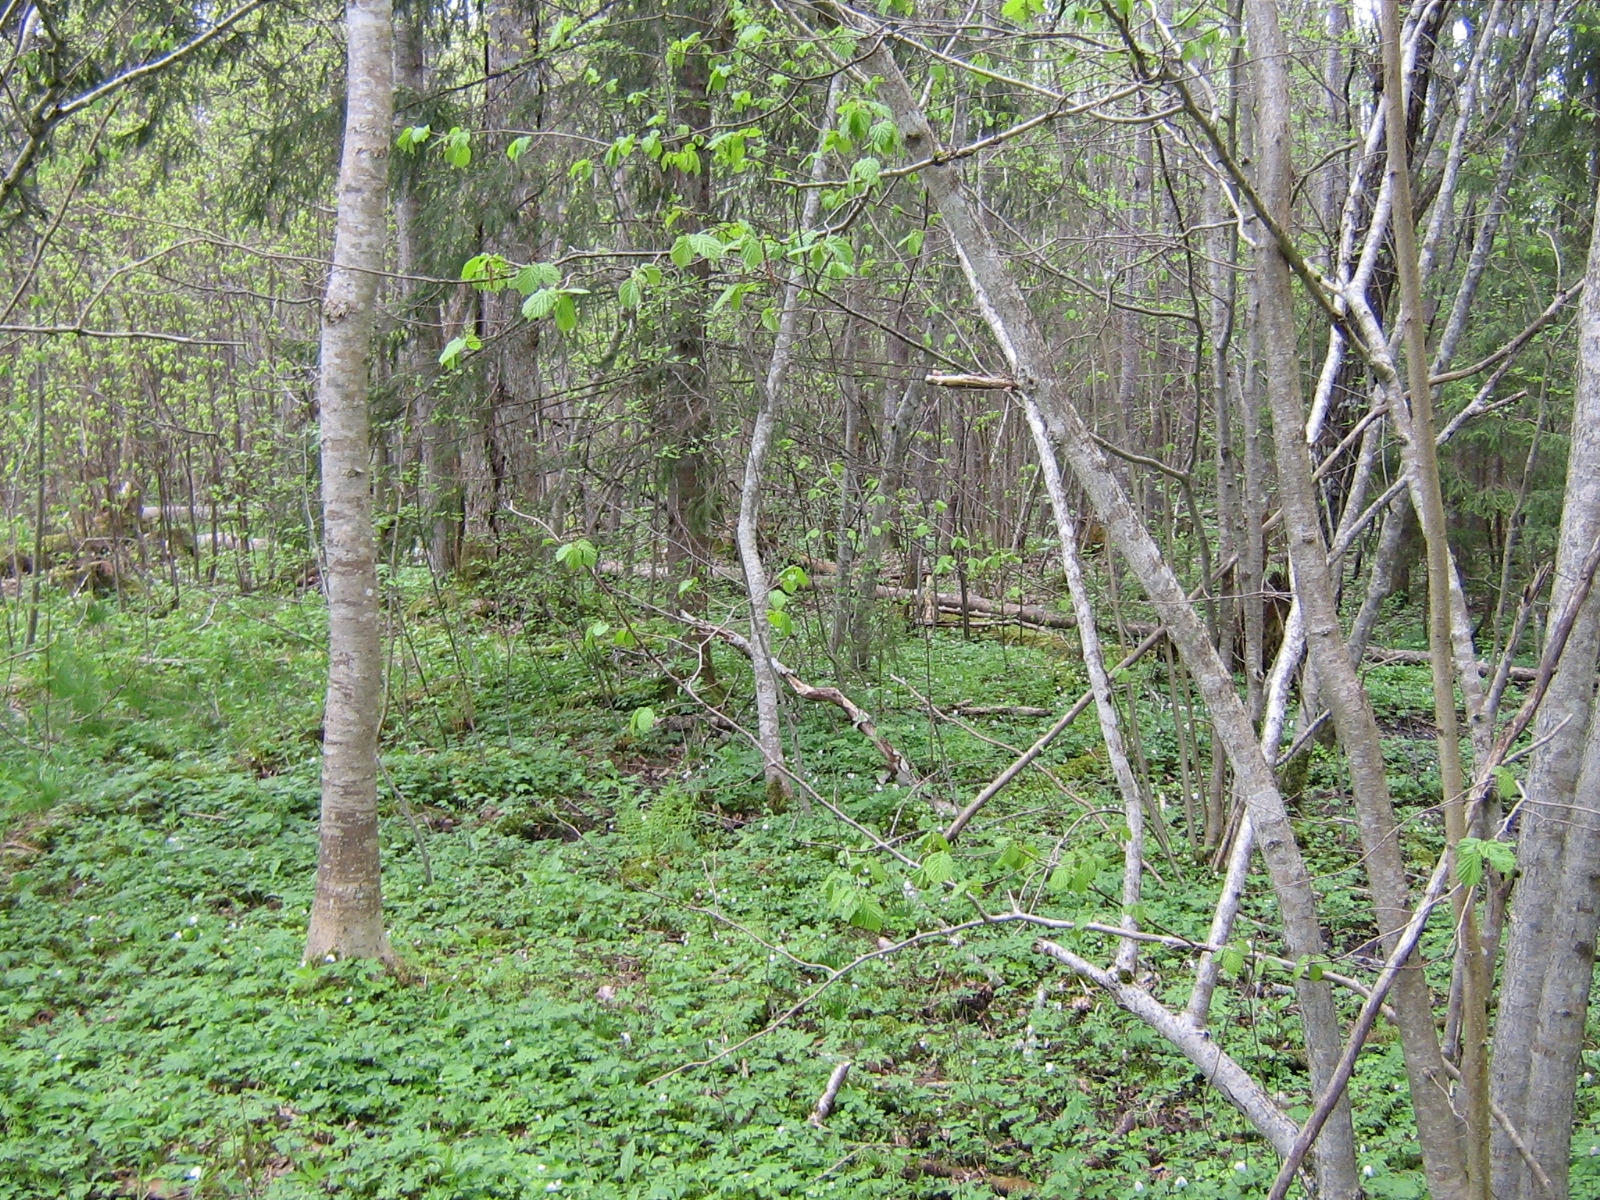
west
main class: Woodland
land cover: Spruce dominated mixed woodland
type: hemiboreal forest and nemoral coniferous forest and mixed broadleaved-coniferous forest
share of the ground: > 75 %
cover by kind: broadleaved forest trees 60 %, coniferous forest trees 40 %
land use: Forestry
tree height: > 5 m
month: May
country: LV
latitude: 57.1479
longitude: 25.3353
